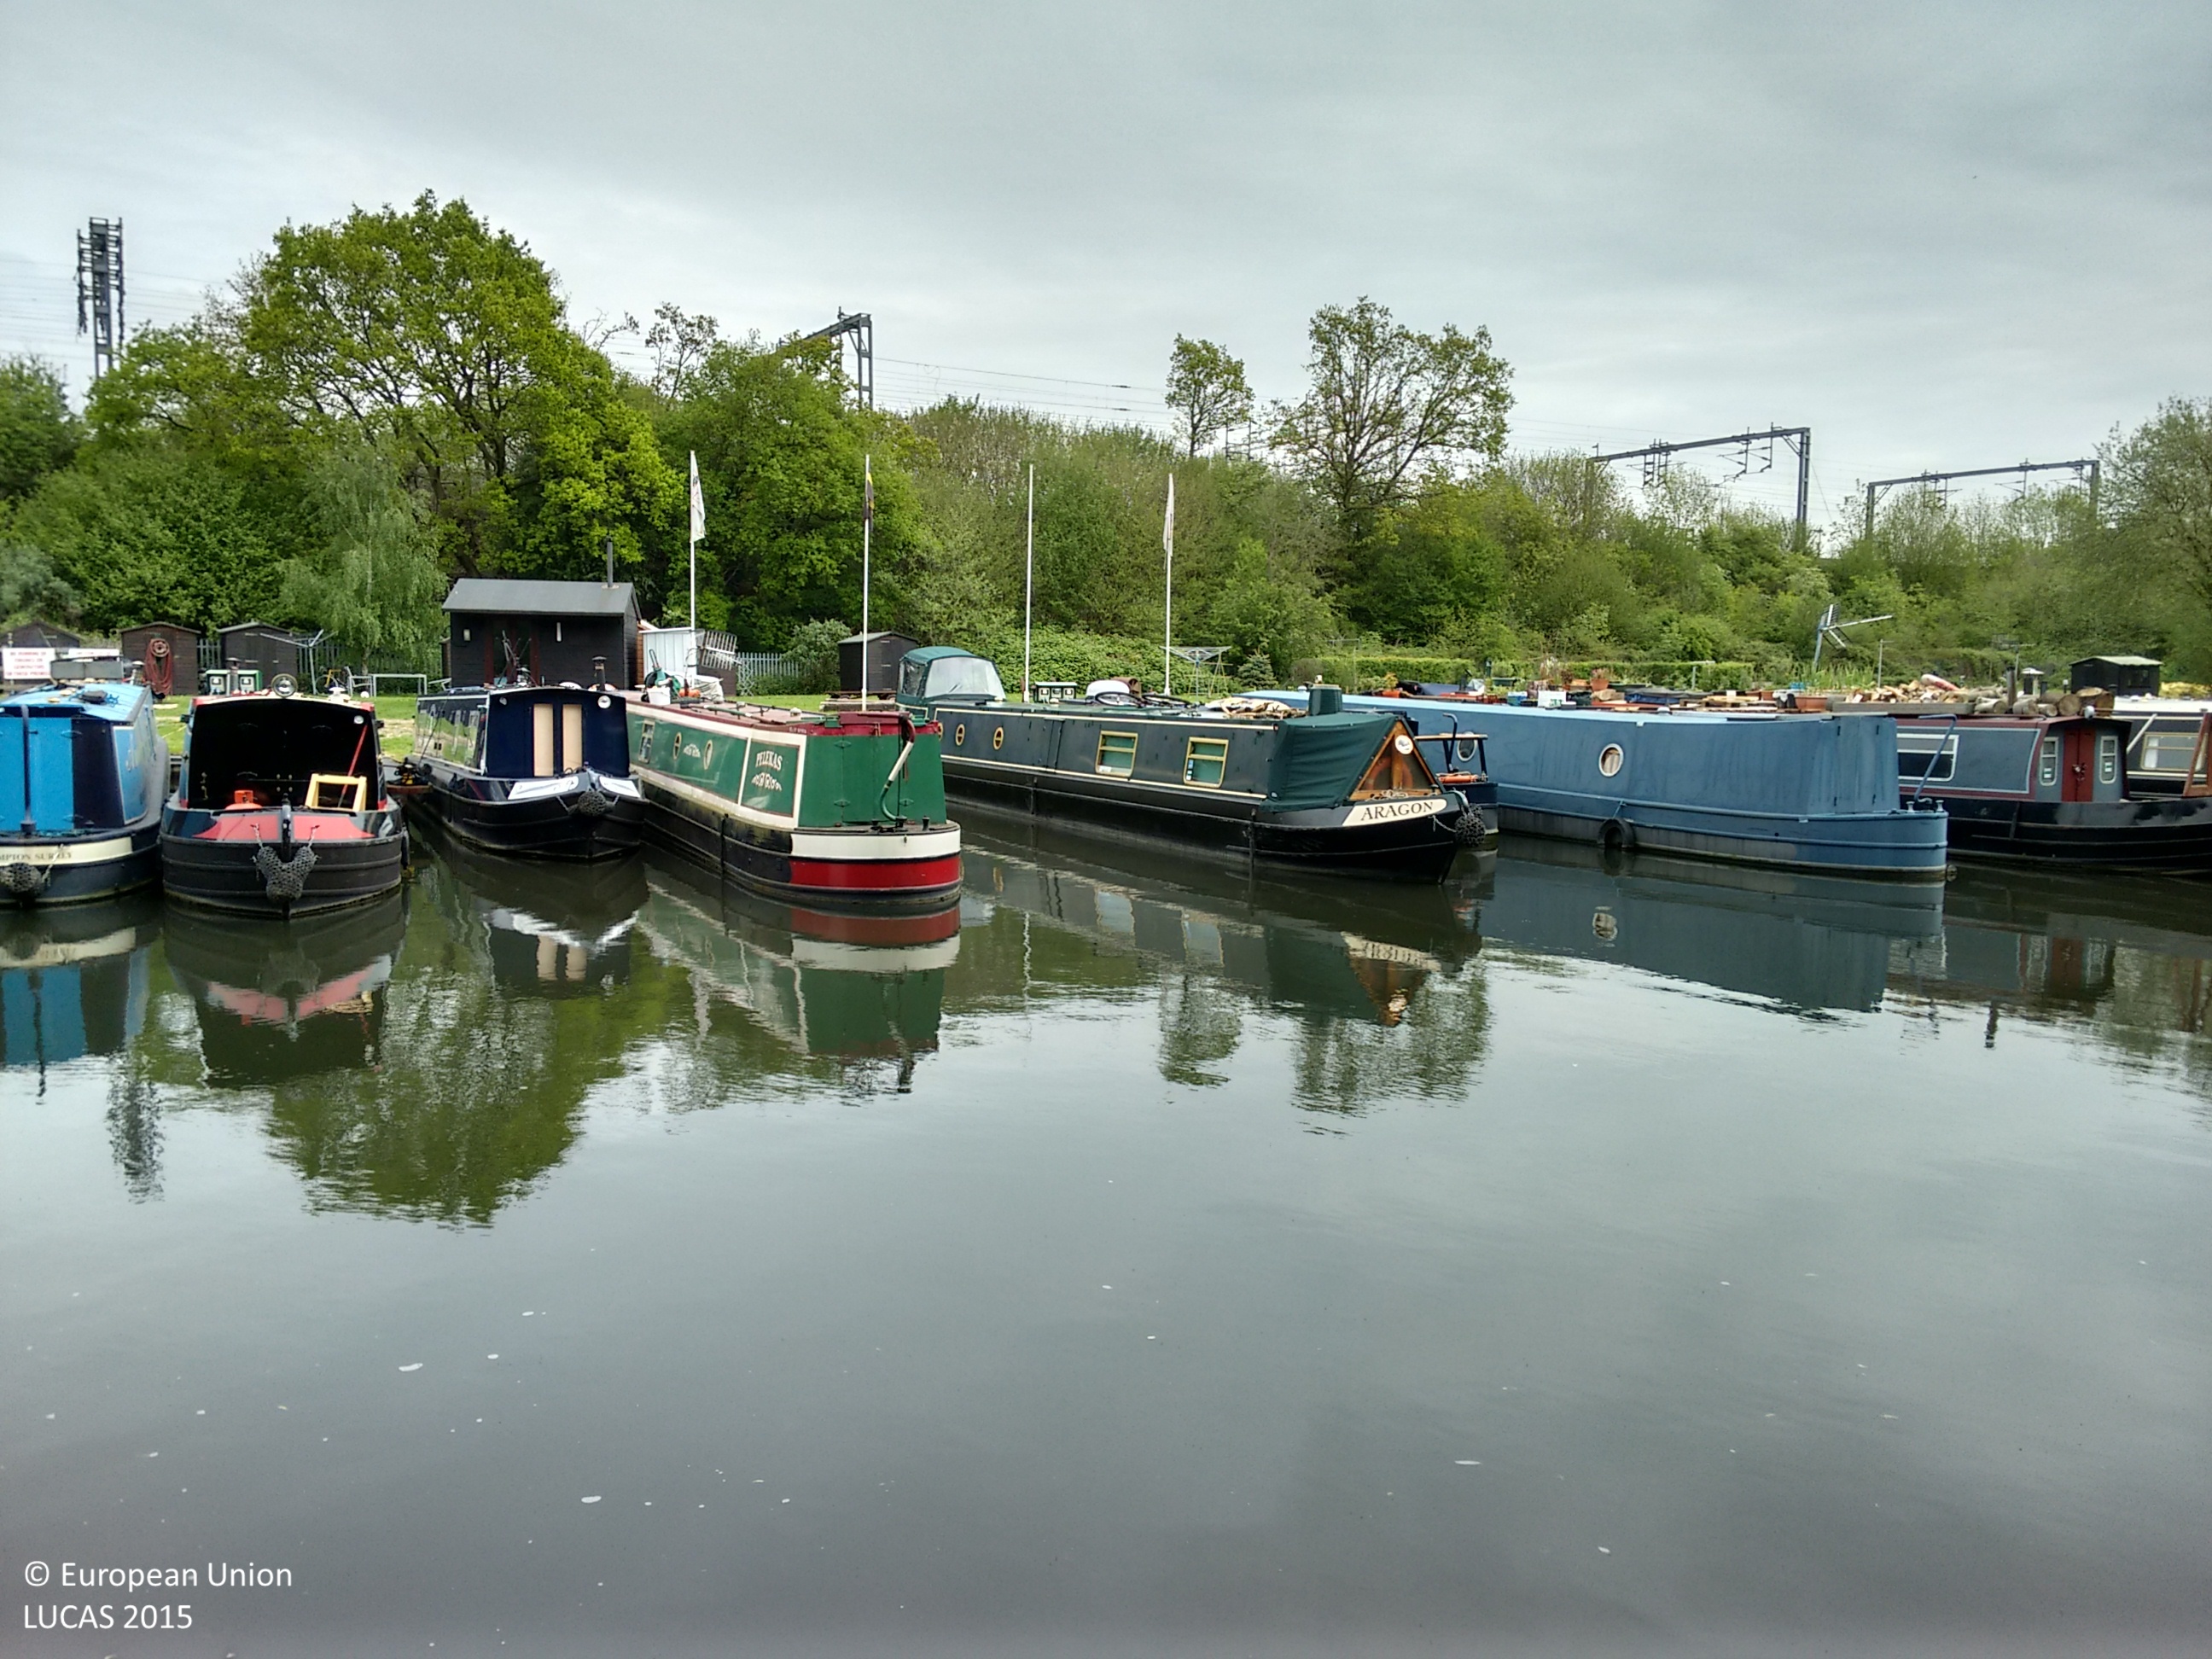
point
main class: Grassland
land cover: Grassland without tree/shrub cover
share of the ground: > 75 %
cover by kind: herbaceous plants 100 %
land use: Amenities, museums, leisure
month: May
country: GB
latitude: 51.7463
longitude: -0.5103
